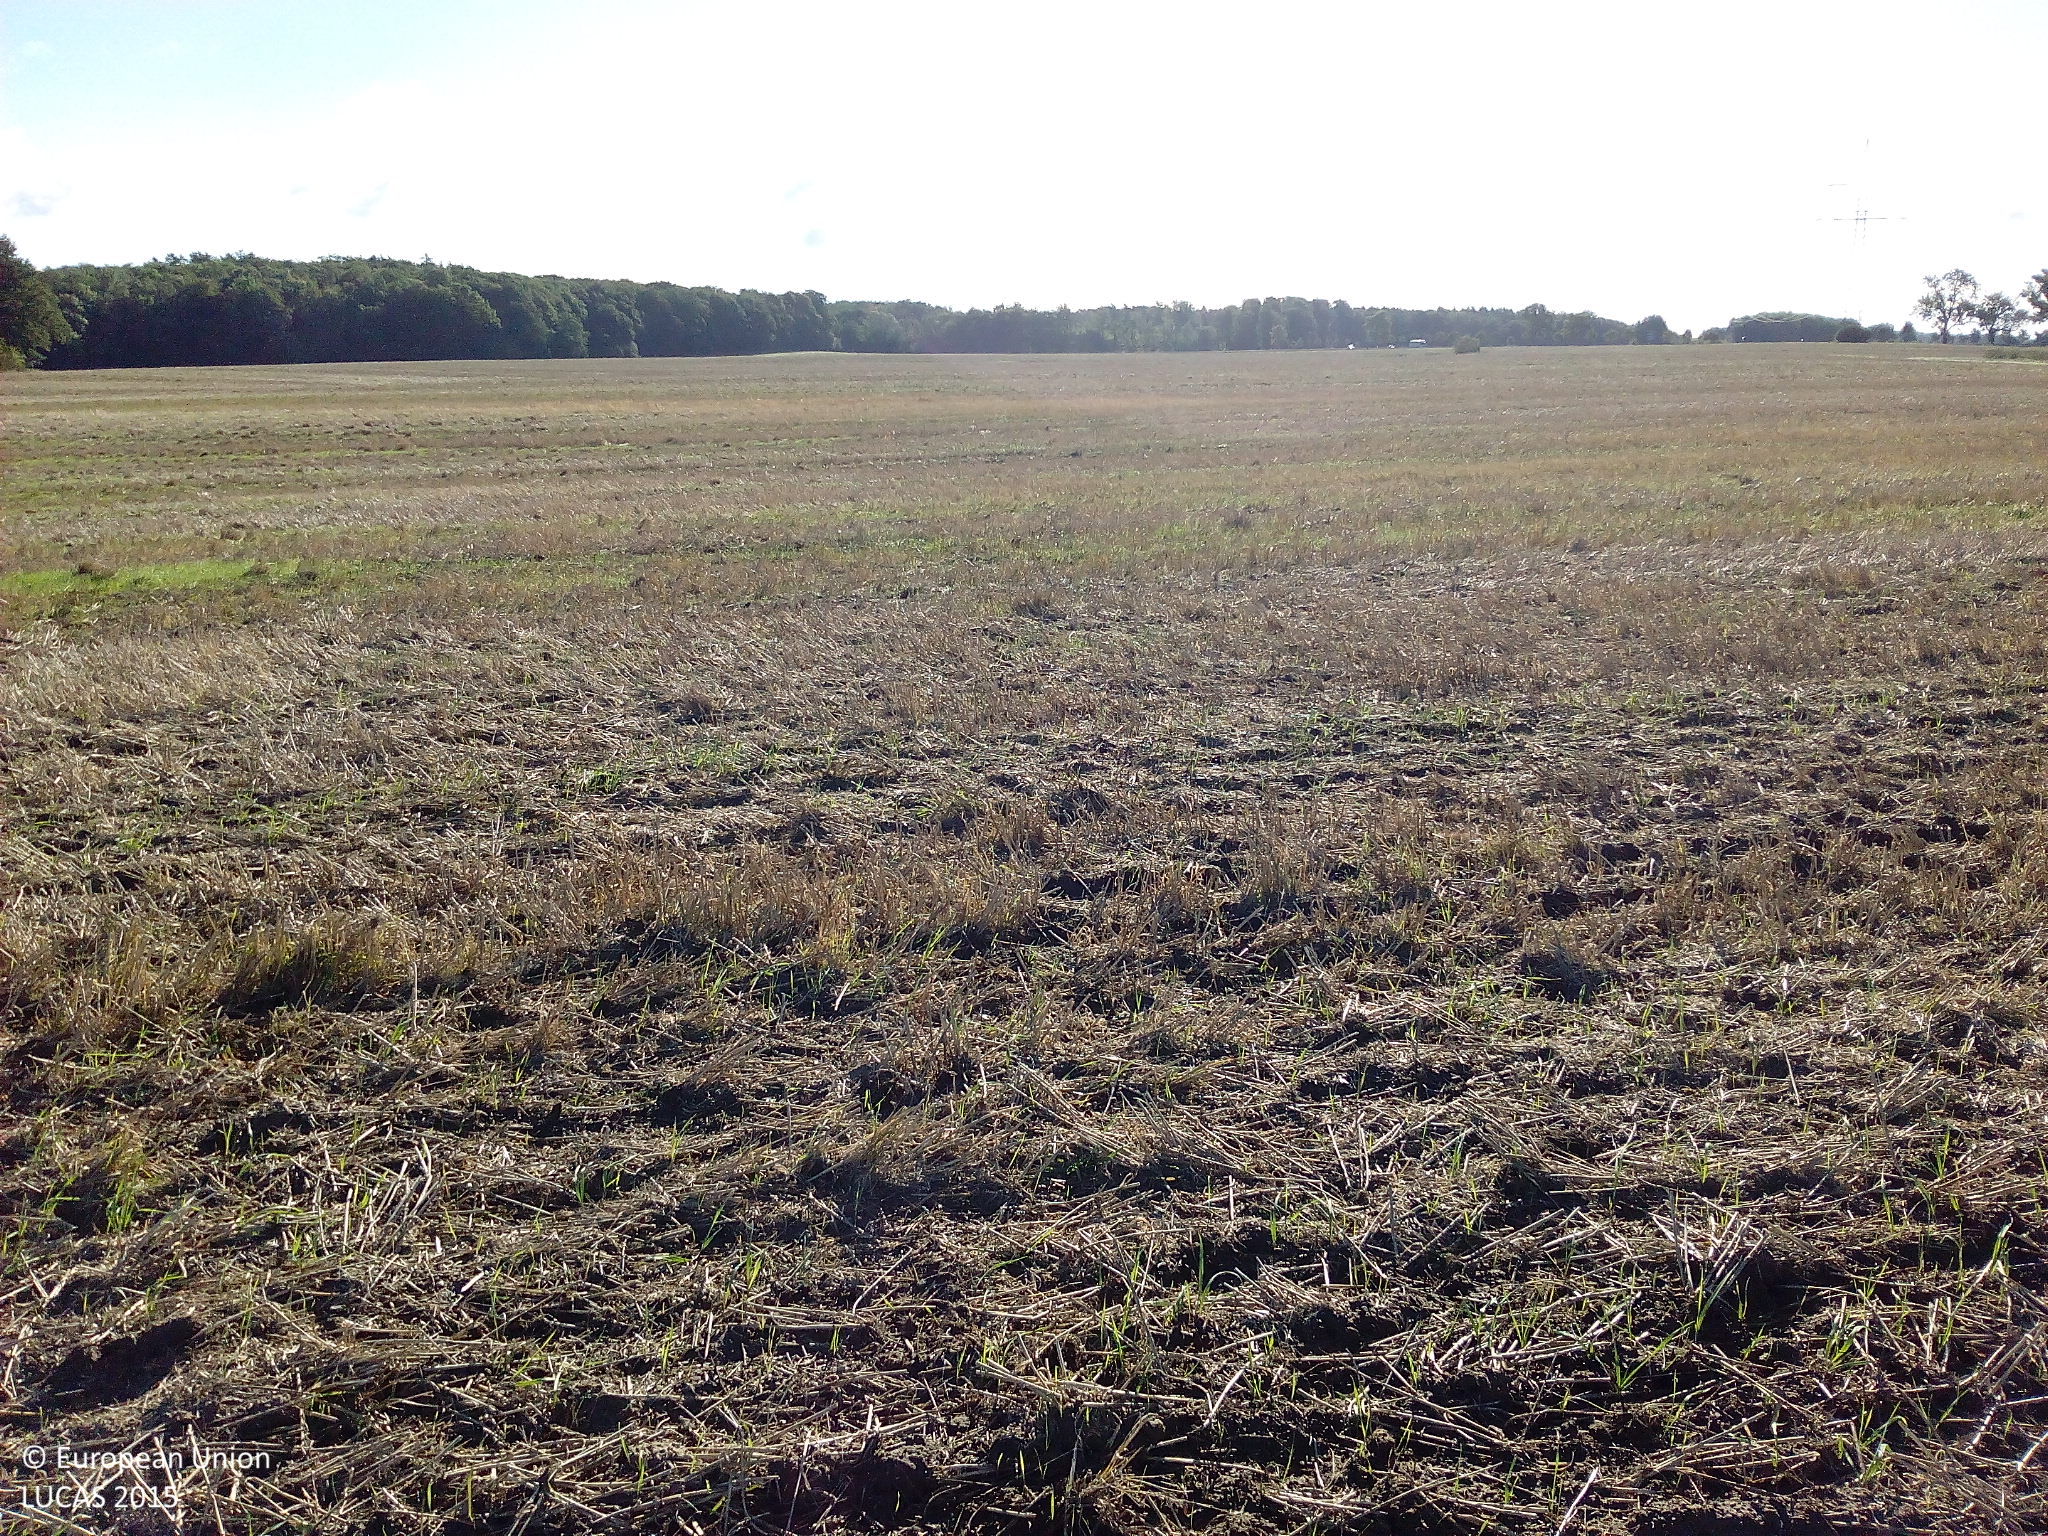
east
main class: Cropland
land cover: Common wheat
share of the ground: 10 - 25 %
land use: Agriculture (excluding fallow land and kitchen gardens)
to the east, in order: Common wheat; Spontaneously vegetated surfaces; Common wheat
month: September
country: DE
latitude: 54.0806
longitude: 12.3377
